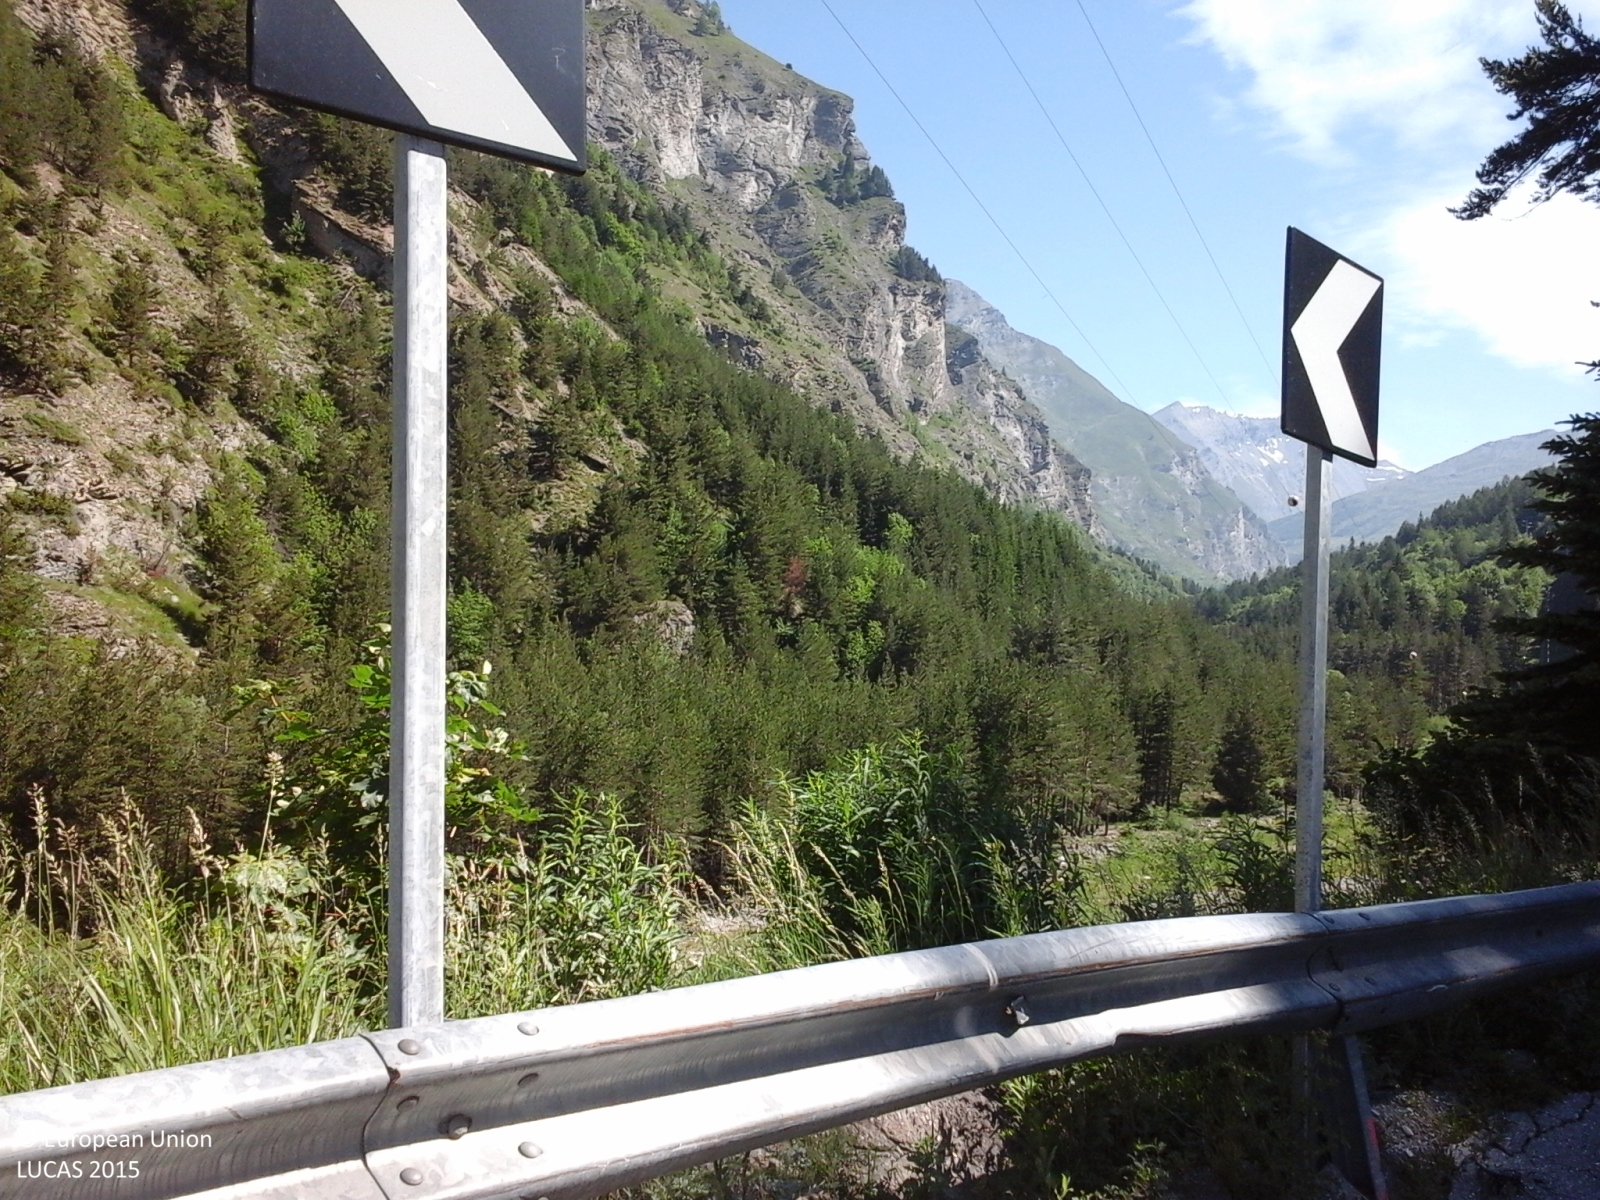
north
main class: Shrubland
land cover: Shrubland without tree cover
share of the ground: 10 - 25 %
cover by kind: herbaceous plants 40 %, consolidated bare surface 40 %, shrubs 20 %
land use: Semi-natural and natural areas not in use
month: June
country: IT
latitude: 45.0925
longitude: 6.7142
